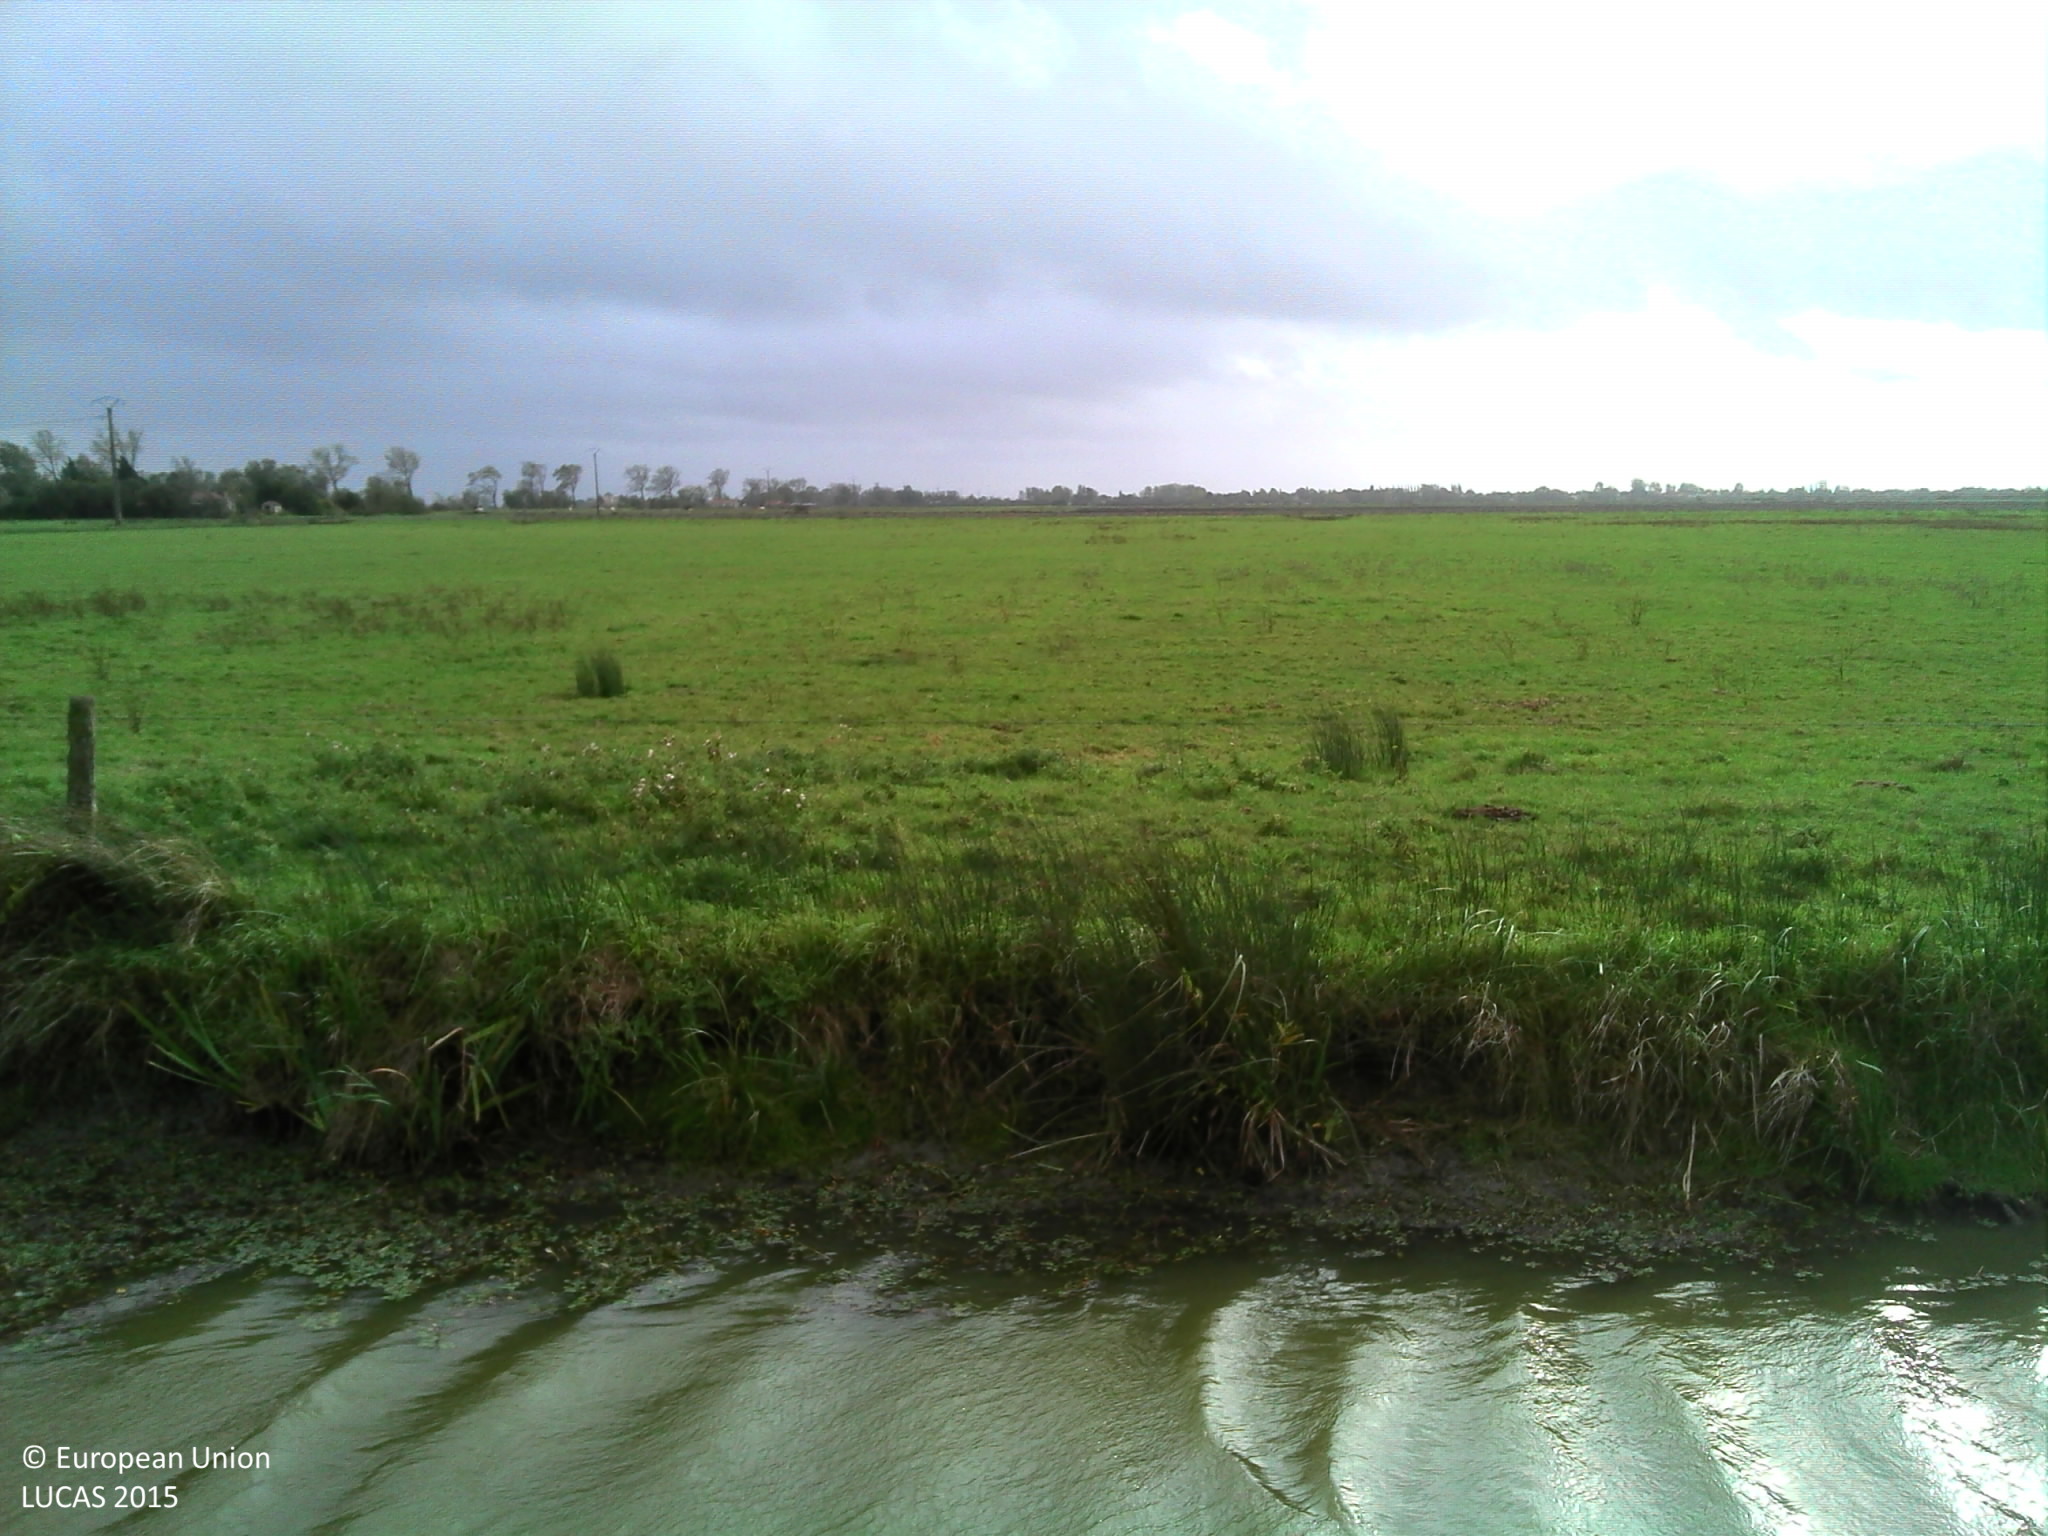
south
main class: Grassland
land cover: Grassland without tree/shrub cover
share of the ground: > 75 %
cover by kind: herbaceous plants 100 %
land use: Agriculture (excluding fallow land and kitchen gardens)
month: October
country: FR
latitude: 46.3949
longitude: -1.0473
